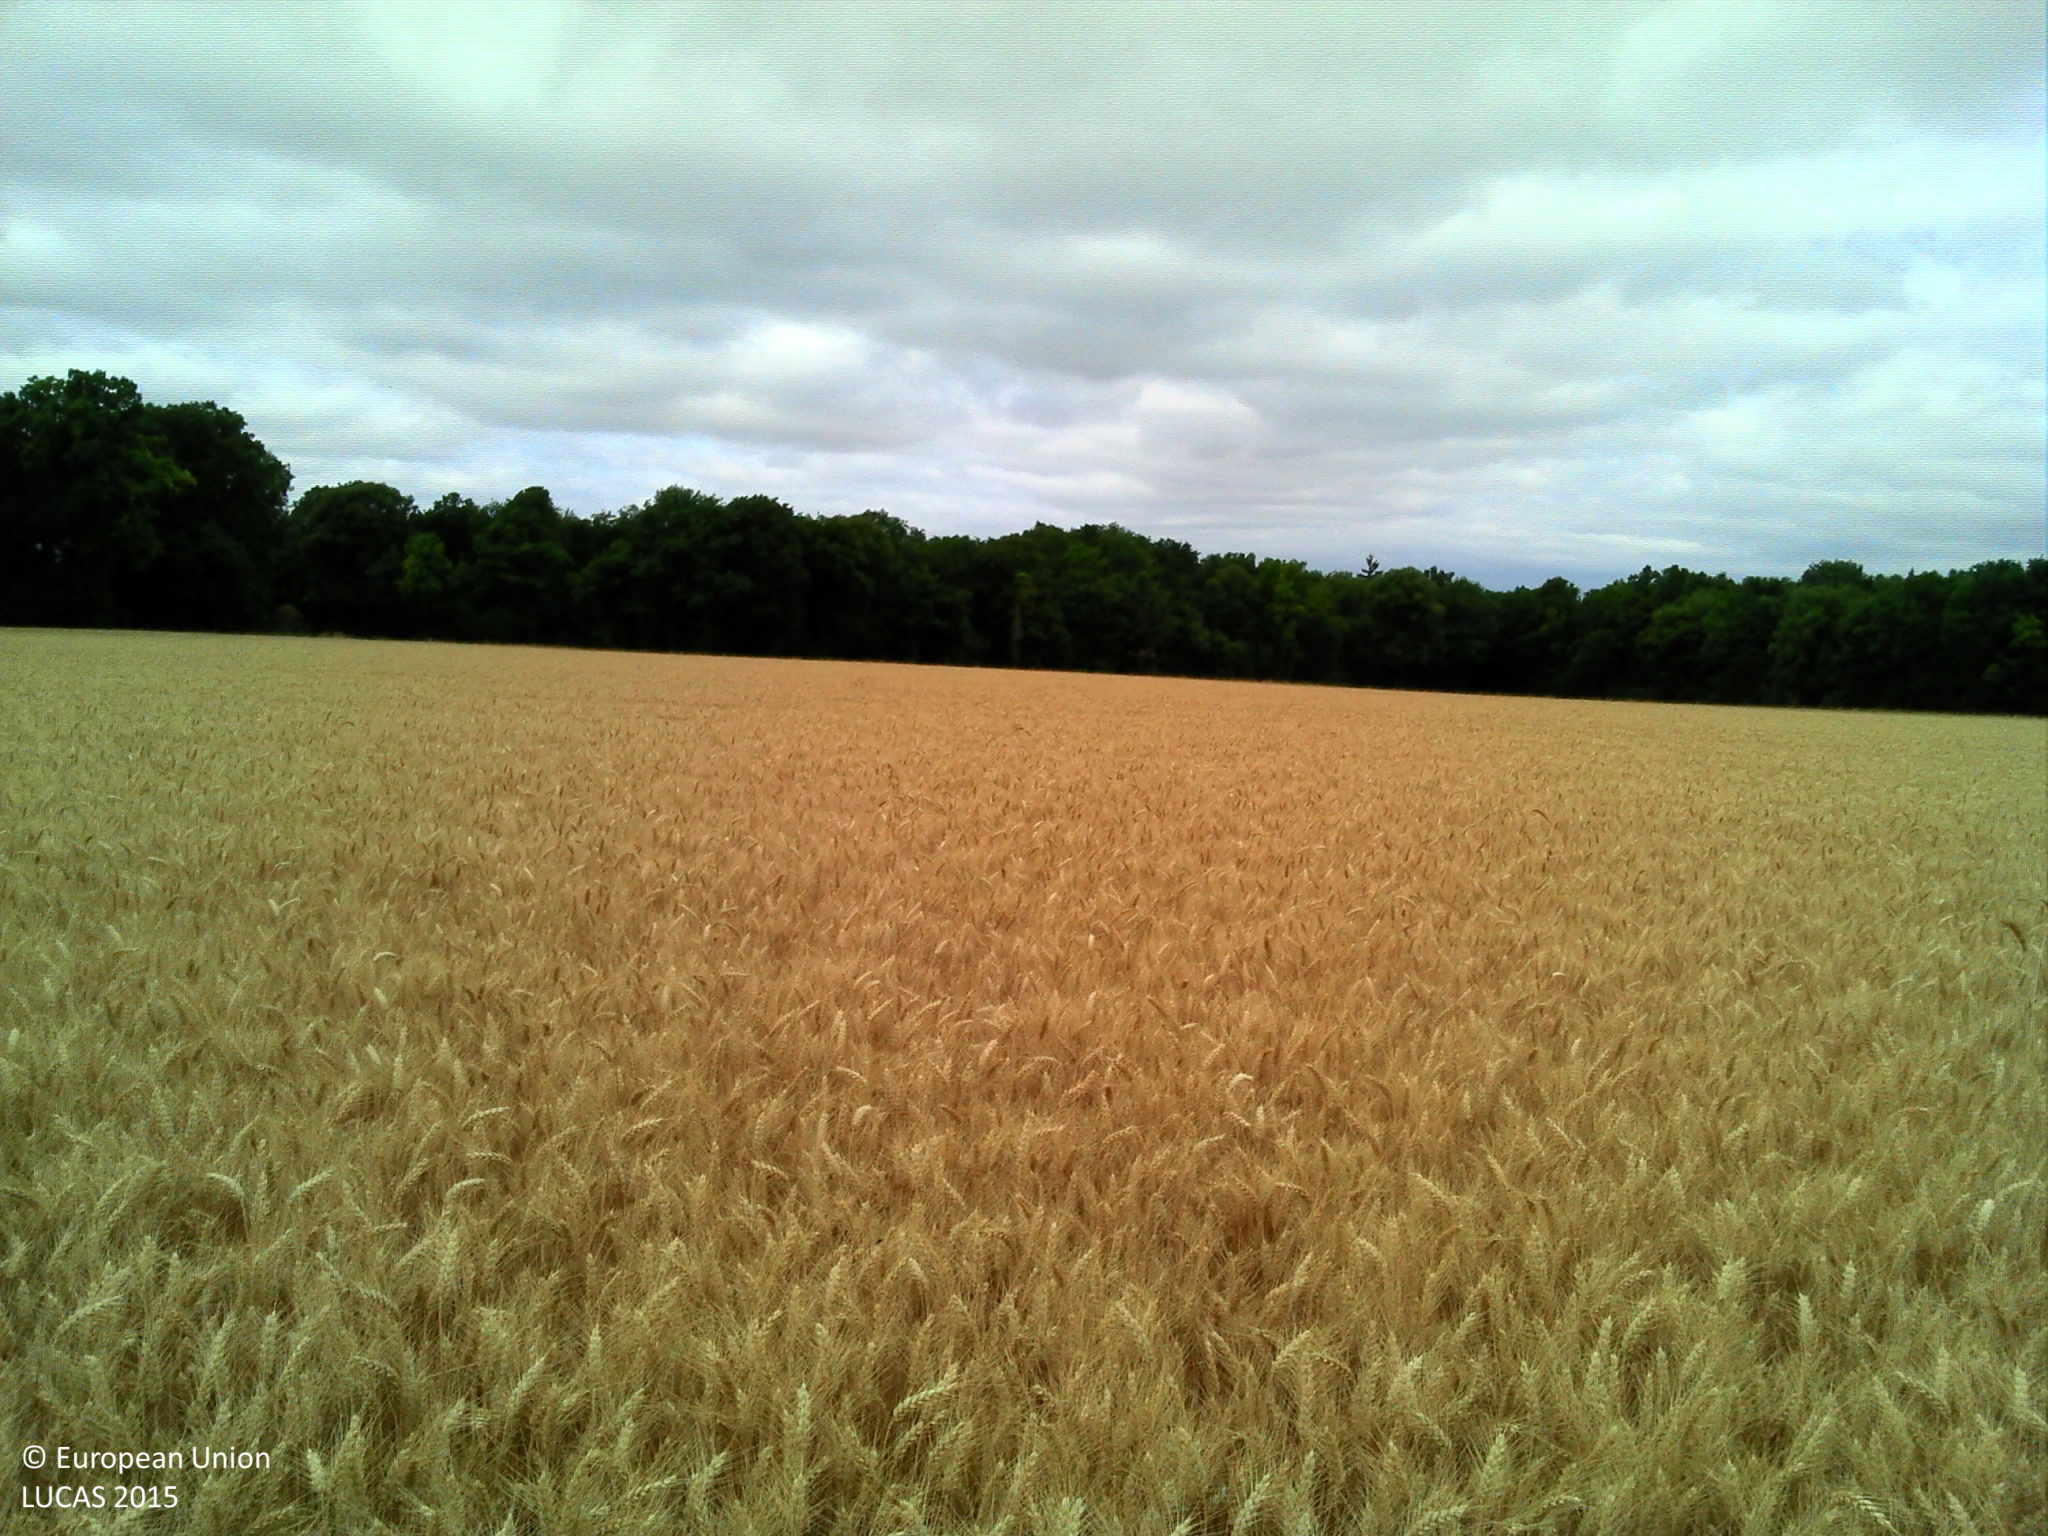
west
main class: Cropland
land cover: Common wheat
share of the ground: > 75 %
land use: Agriculture (excluding fallow land and kitchen gardens)
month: July
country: FR
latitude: 49.3252
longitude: 2.2681
